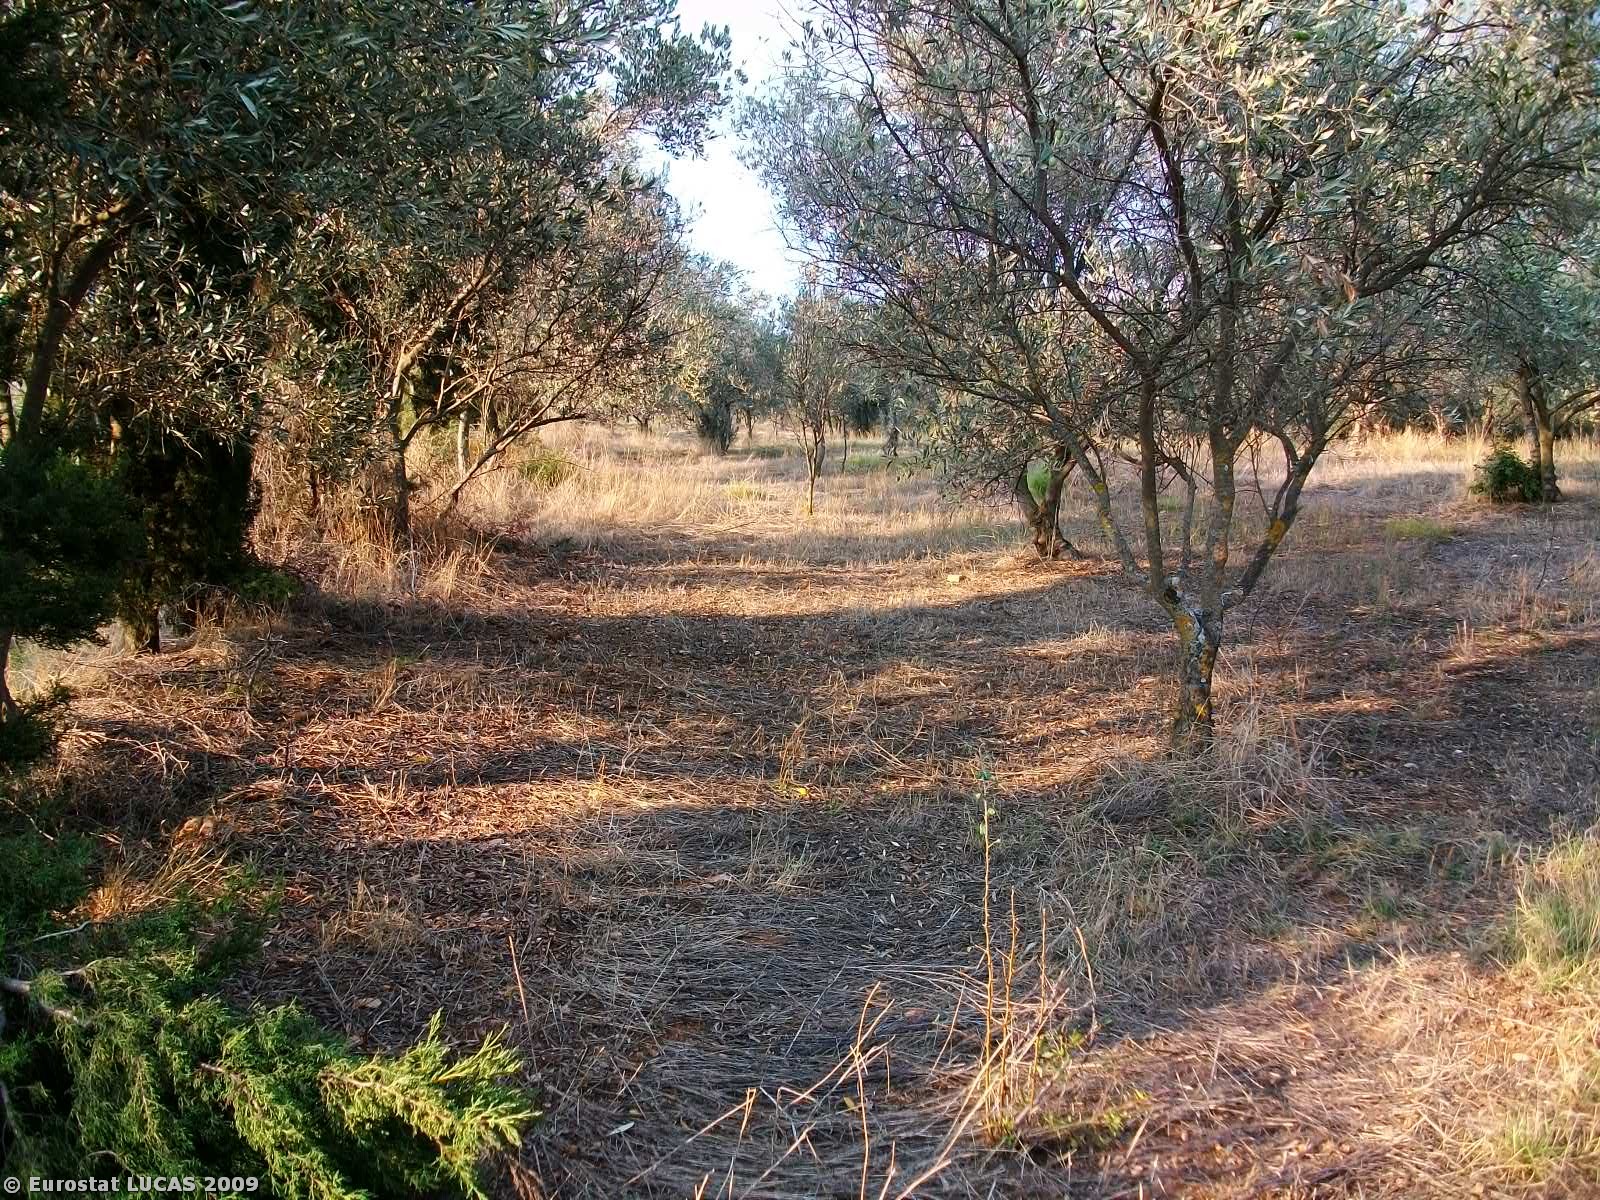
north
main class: Cropland
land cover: Olive groves
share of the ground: 50 - 75 %
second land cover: Grassland with sparse tree/shrub cover
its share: > 75 %
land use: Agriculture (excluding fallow land and kitchen gardens)
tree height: < 5 m
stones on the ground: 10 - 25 %
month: September
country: GR
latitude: 38.6216
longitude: 21.4907
